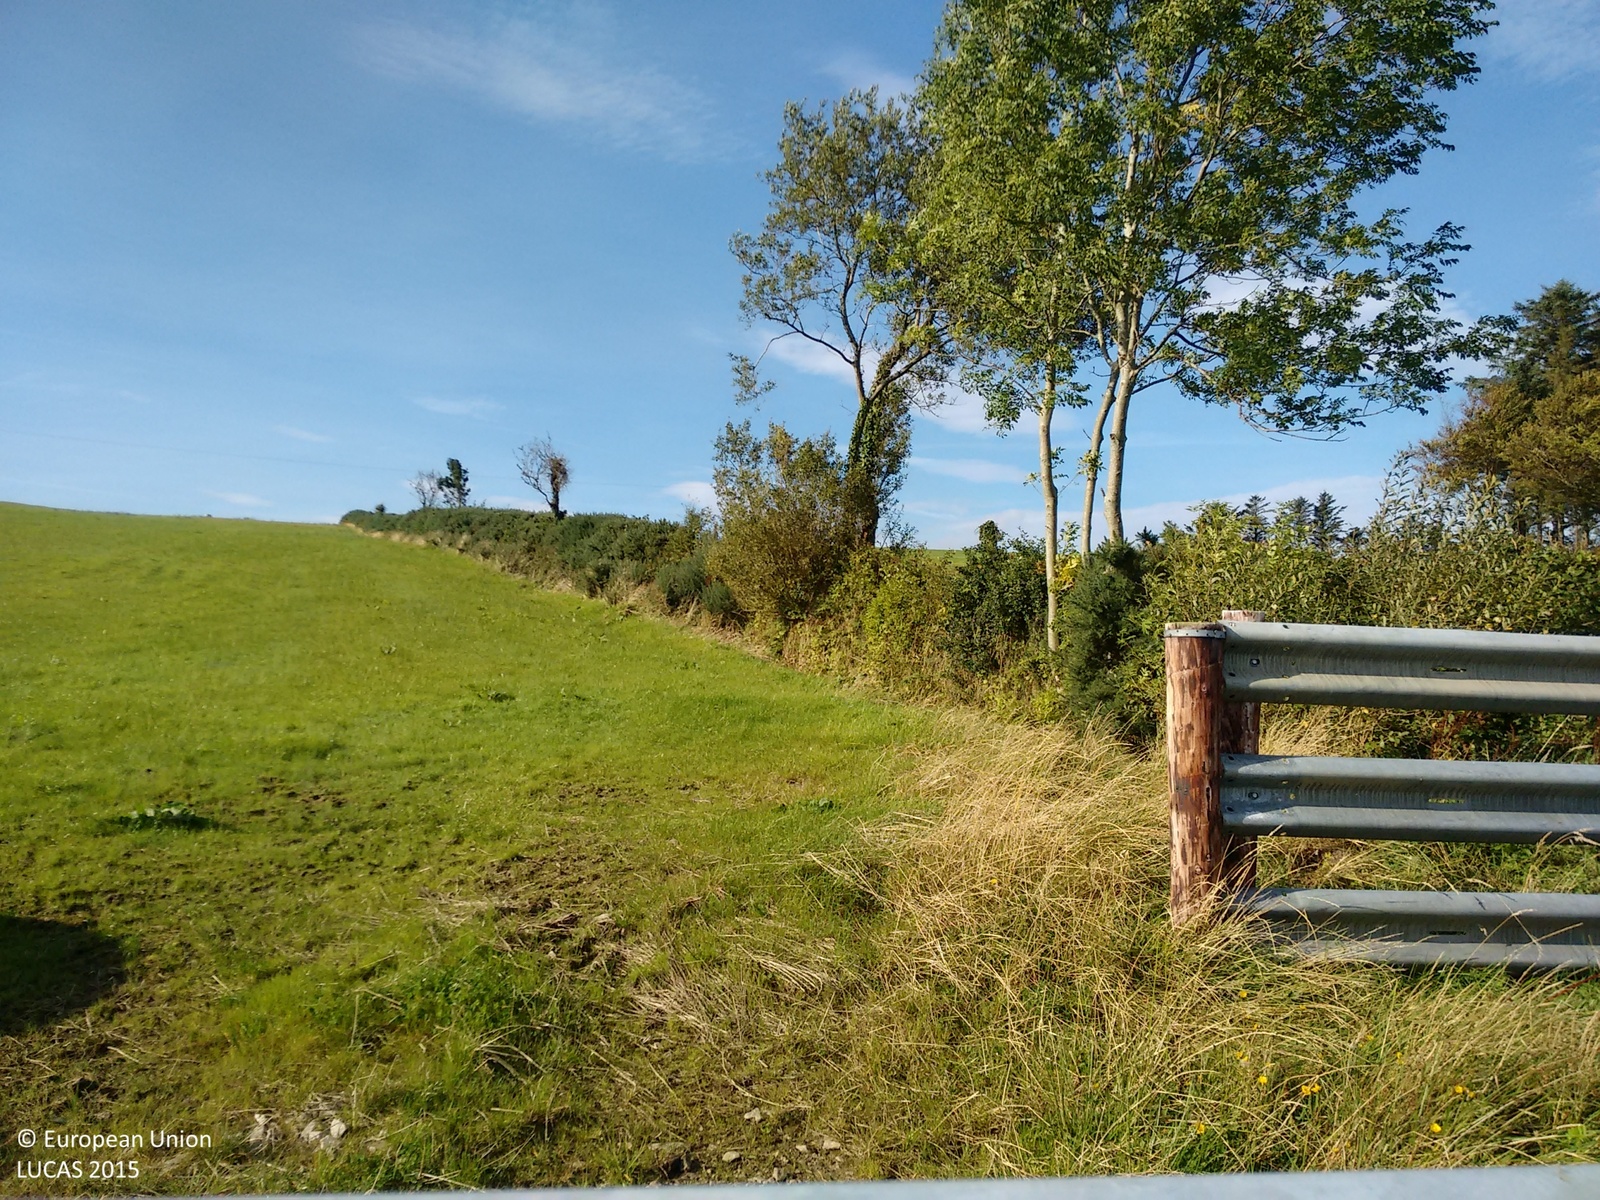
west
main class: Grassland
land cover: Grassland without tree/shrub cover
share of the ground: > 75 %
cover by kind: herbaceous plants 100 %
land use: Agriculture (excluding fallow land and kitchen gardens)
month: September
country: IE
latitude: 55.1598
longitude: -7.7243
